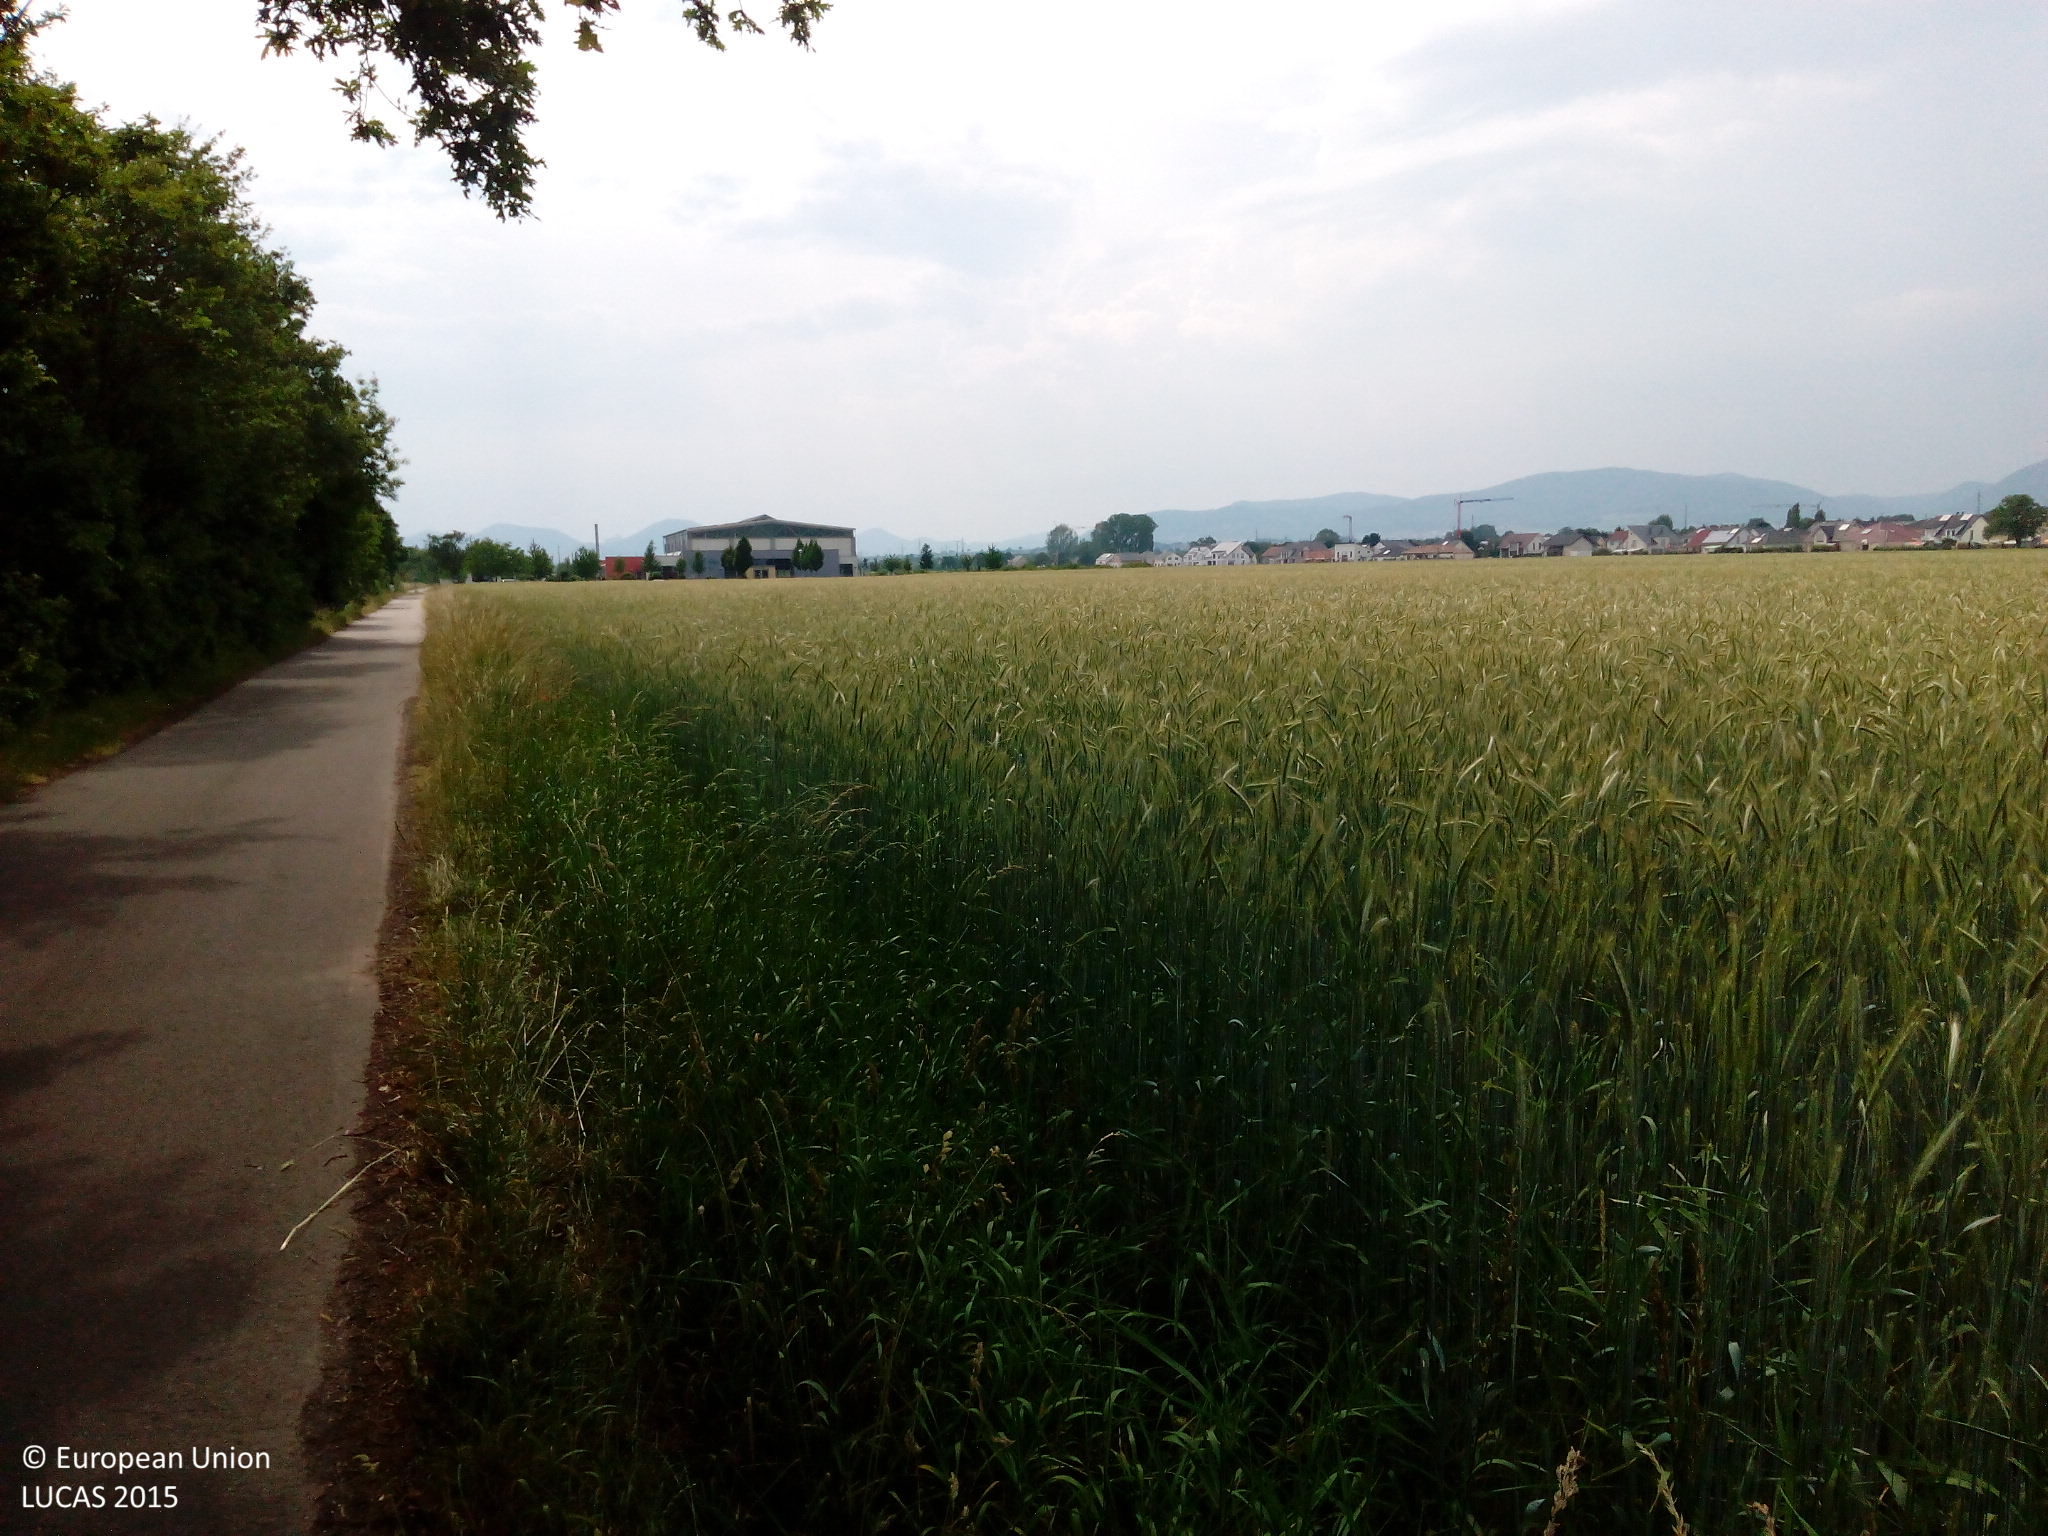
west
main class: Cropland
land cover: Rye
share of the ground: > 75 %
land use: Agriculture (excluding fallow land and kitchen gardens)
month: June
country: DE
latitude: 49.2162
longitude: 8.1747
